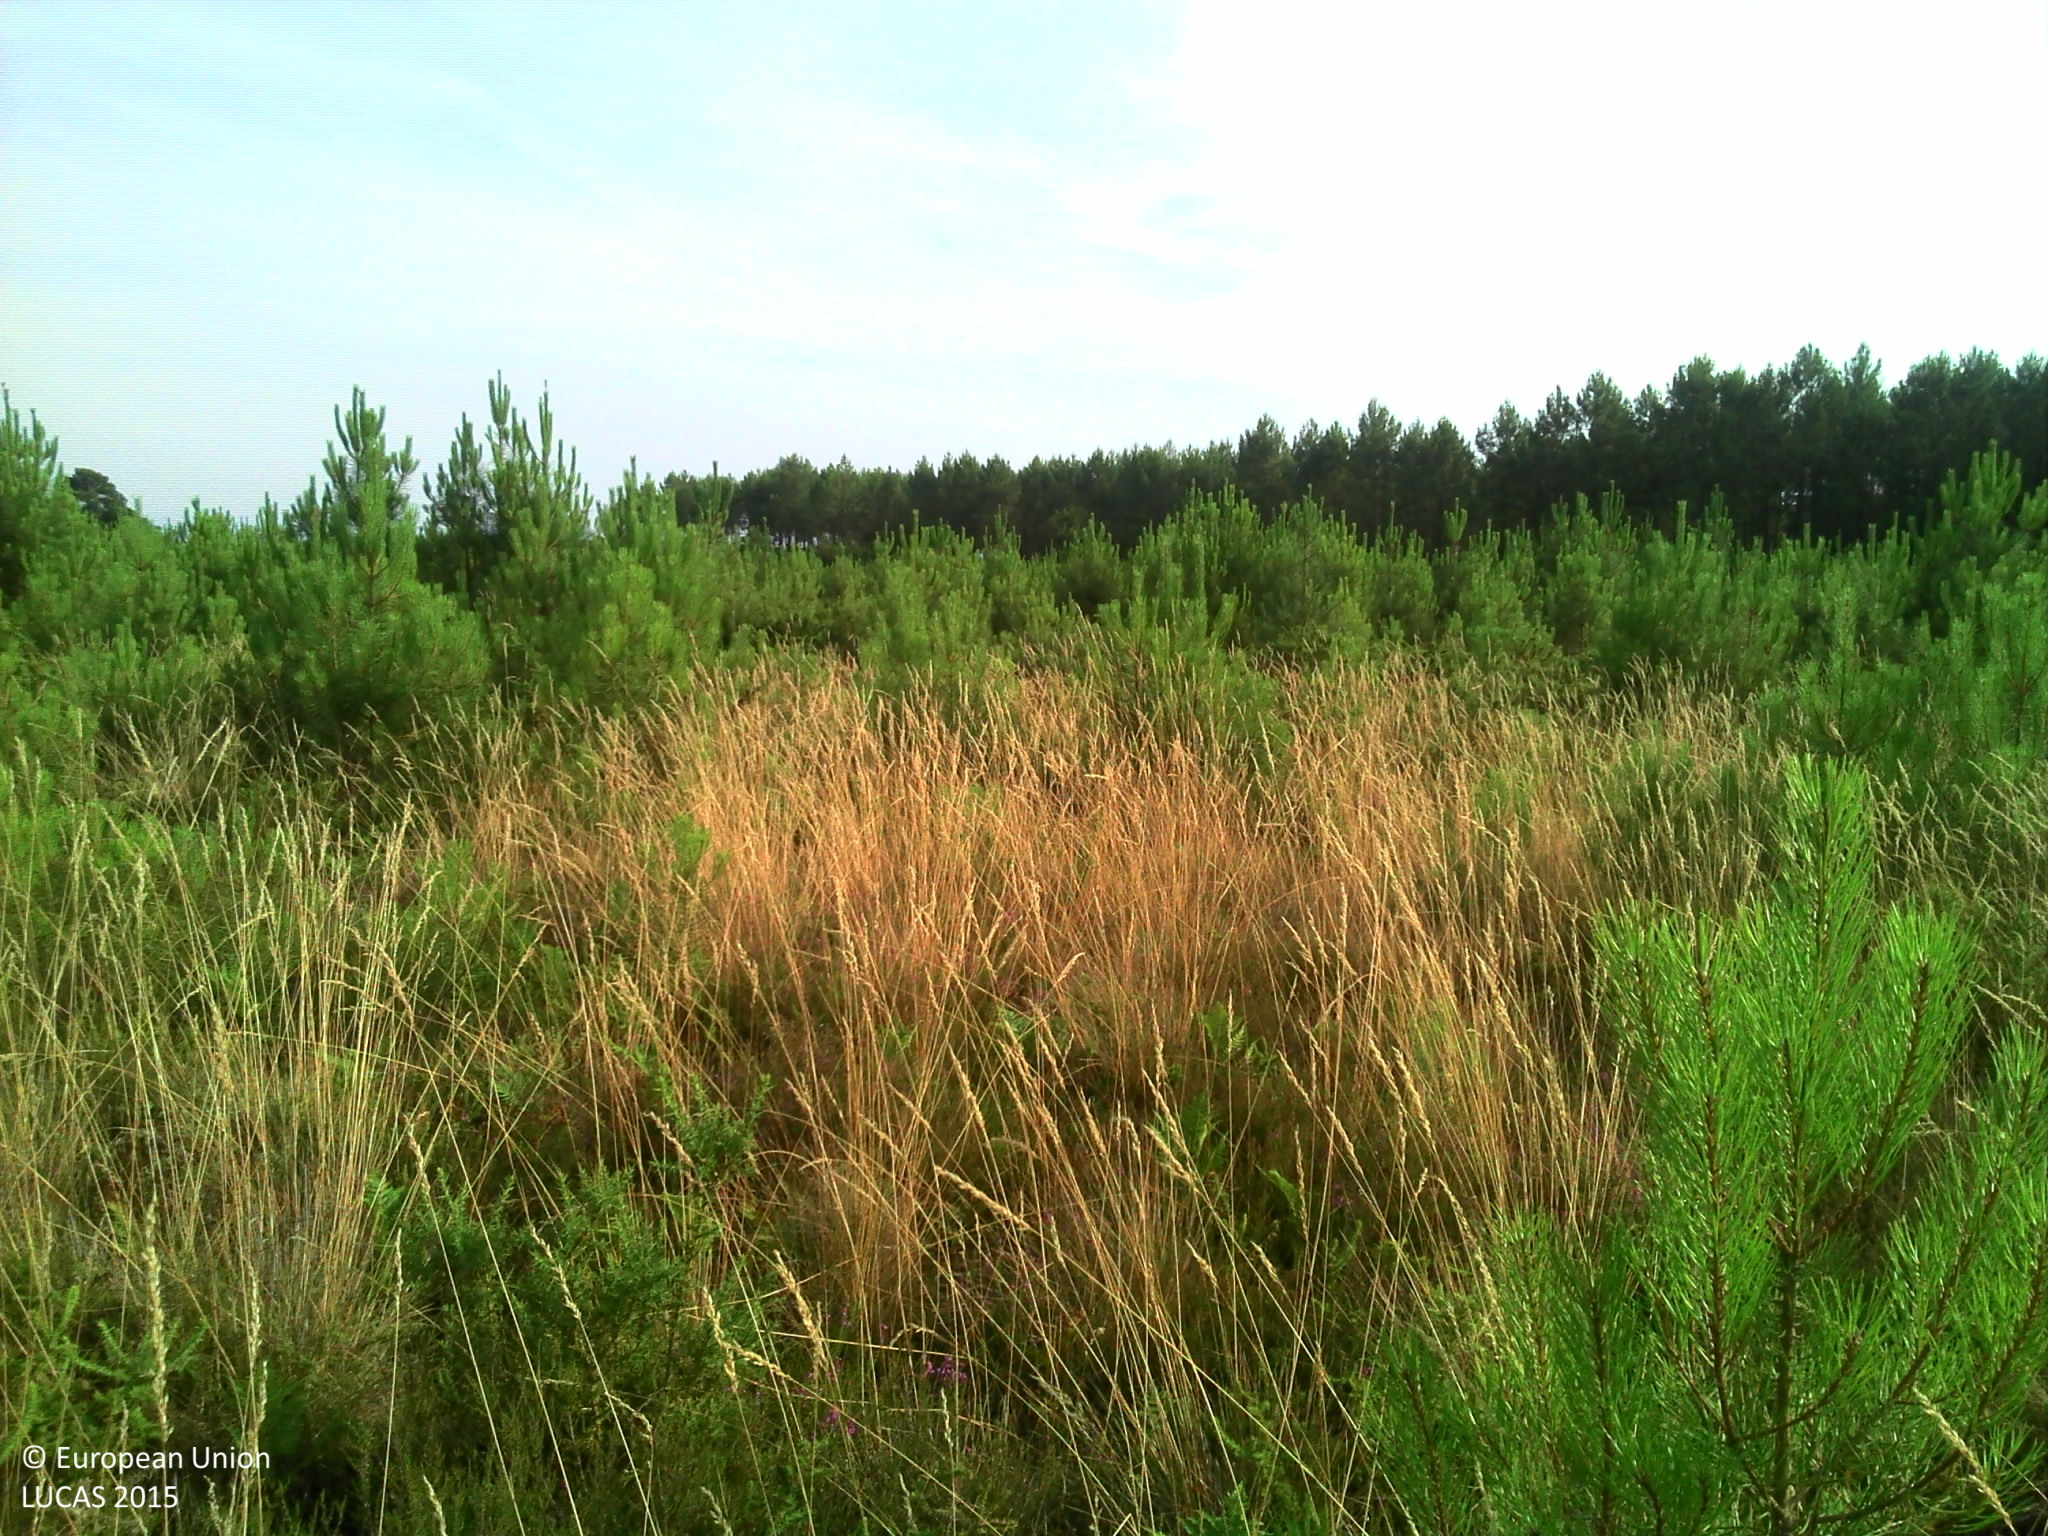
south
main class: Shrubland
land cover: Shrubland with sparse tree cover
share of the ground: > 75 %
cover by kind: shrubs 50 %, herbaceous plants 40 %, coniferous forest trees 5 %, lichens and mosses 5 %
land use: Forestry
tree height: < 5 m
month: July
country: FR
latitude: 43.7309
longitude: -1.3035
